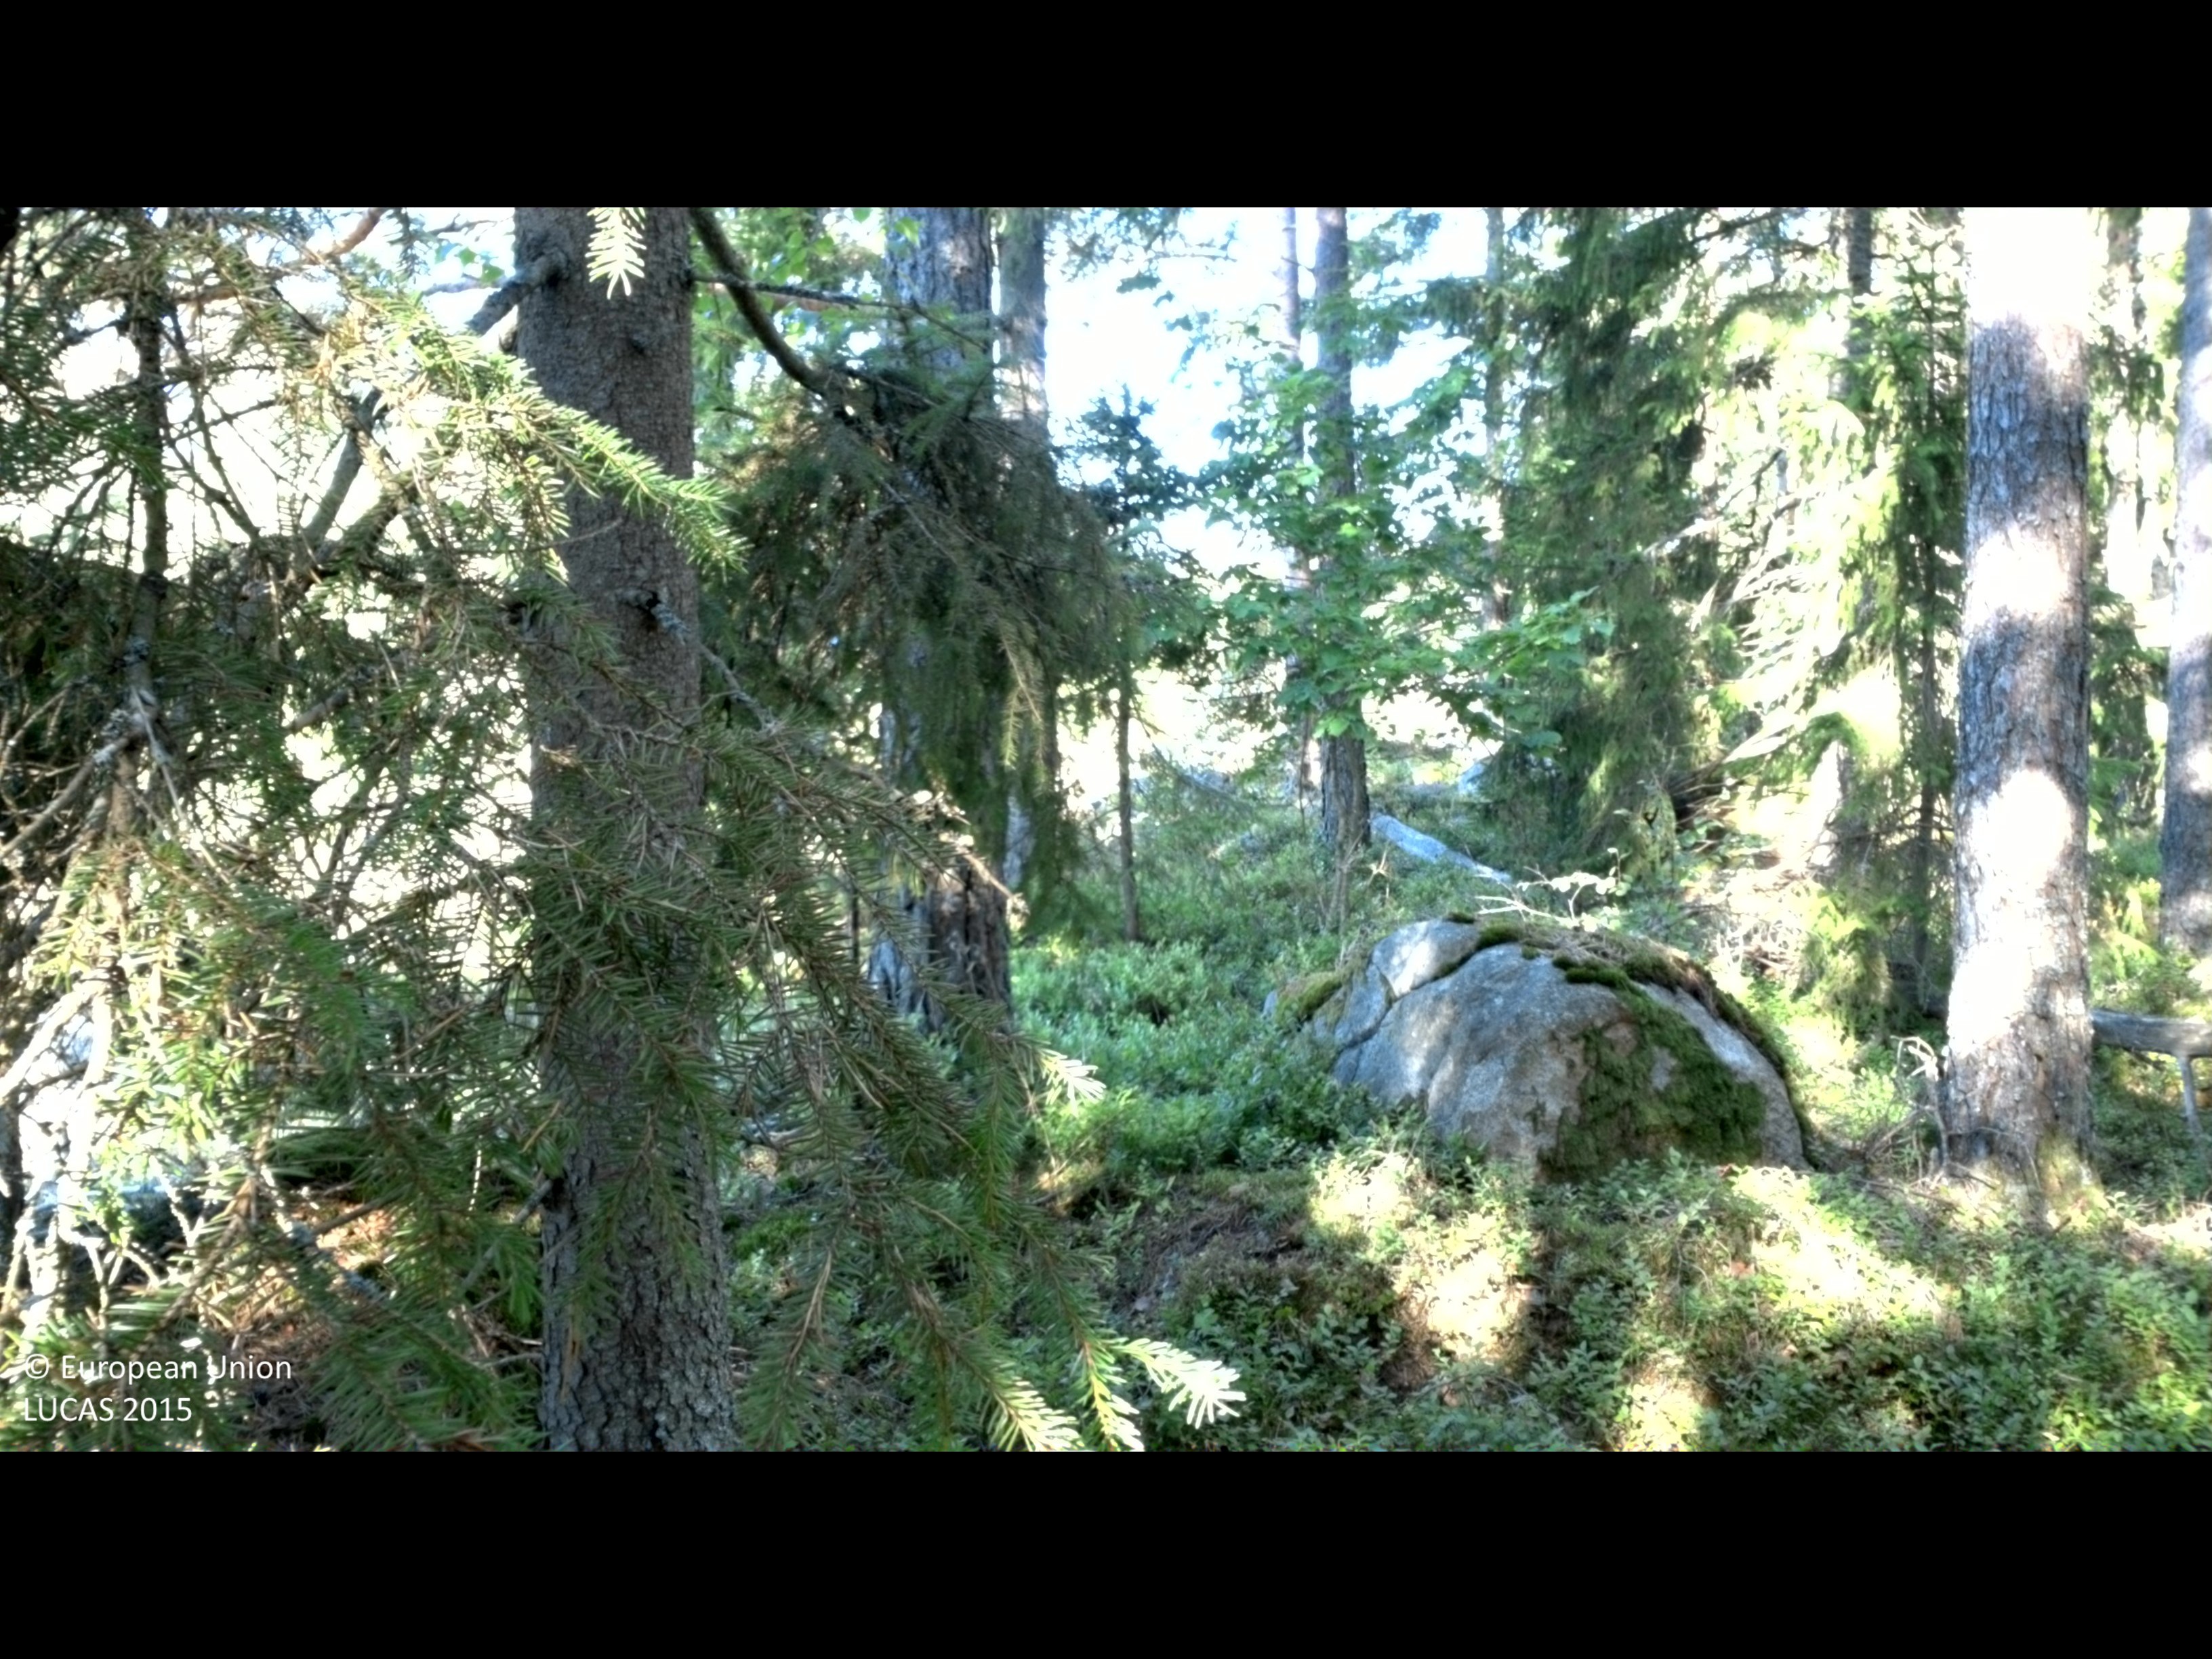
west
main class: Woodland
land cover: Other coniferous woodland
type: boreal forest
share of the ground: > 75 %
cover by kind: coniferous forest trees 75 %, shrubs 20 %, lichens and mosses 5 %
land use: Forestry
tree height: > 5 m
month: August
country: SE
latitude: 56.3154
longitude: 14.7673
